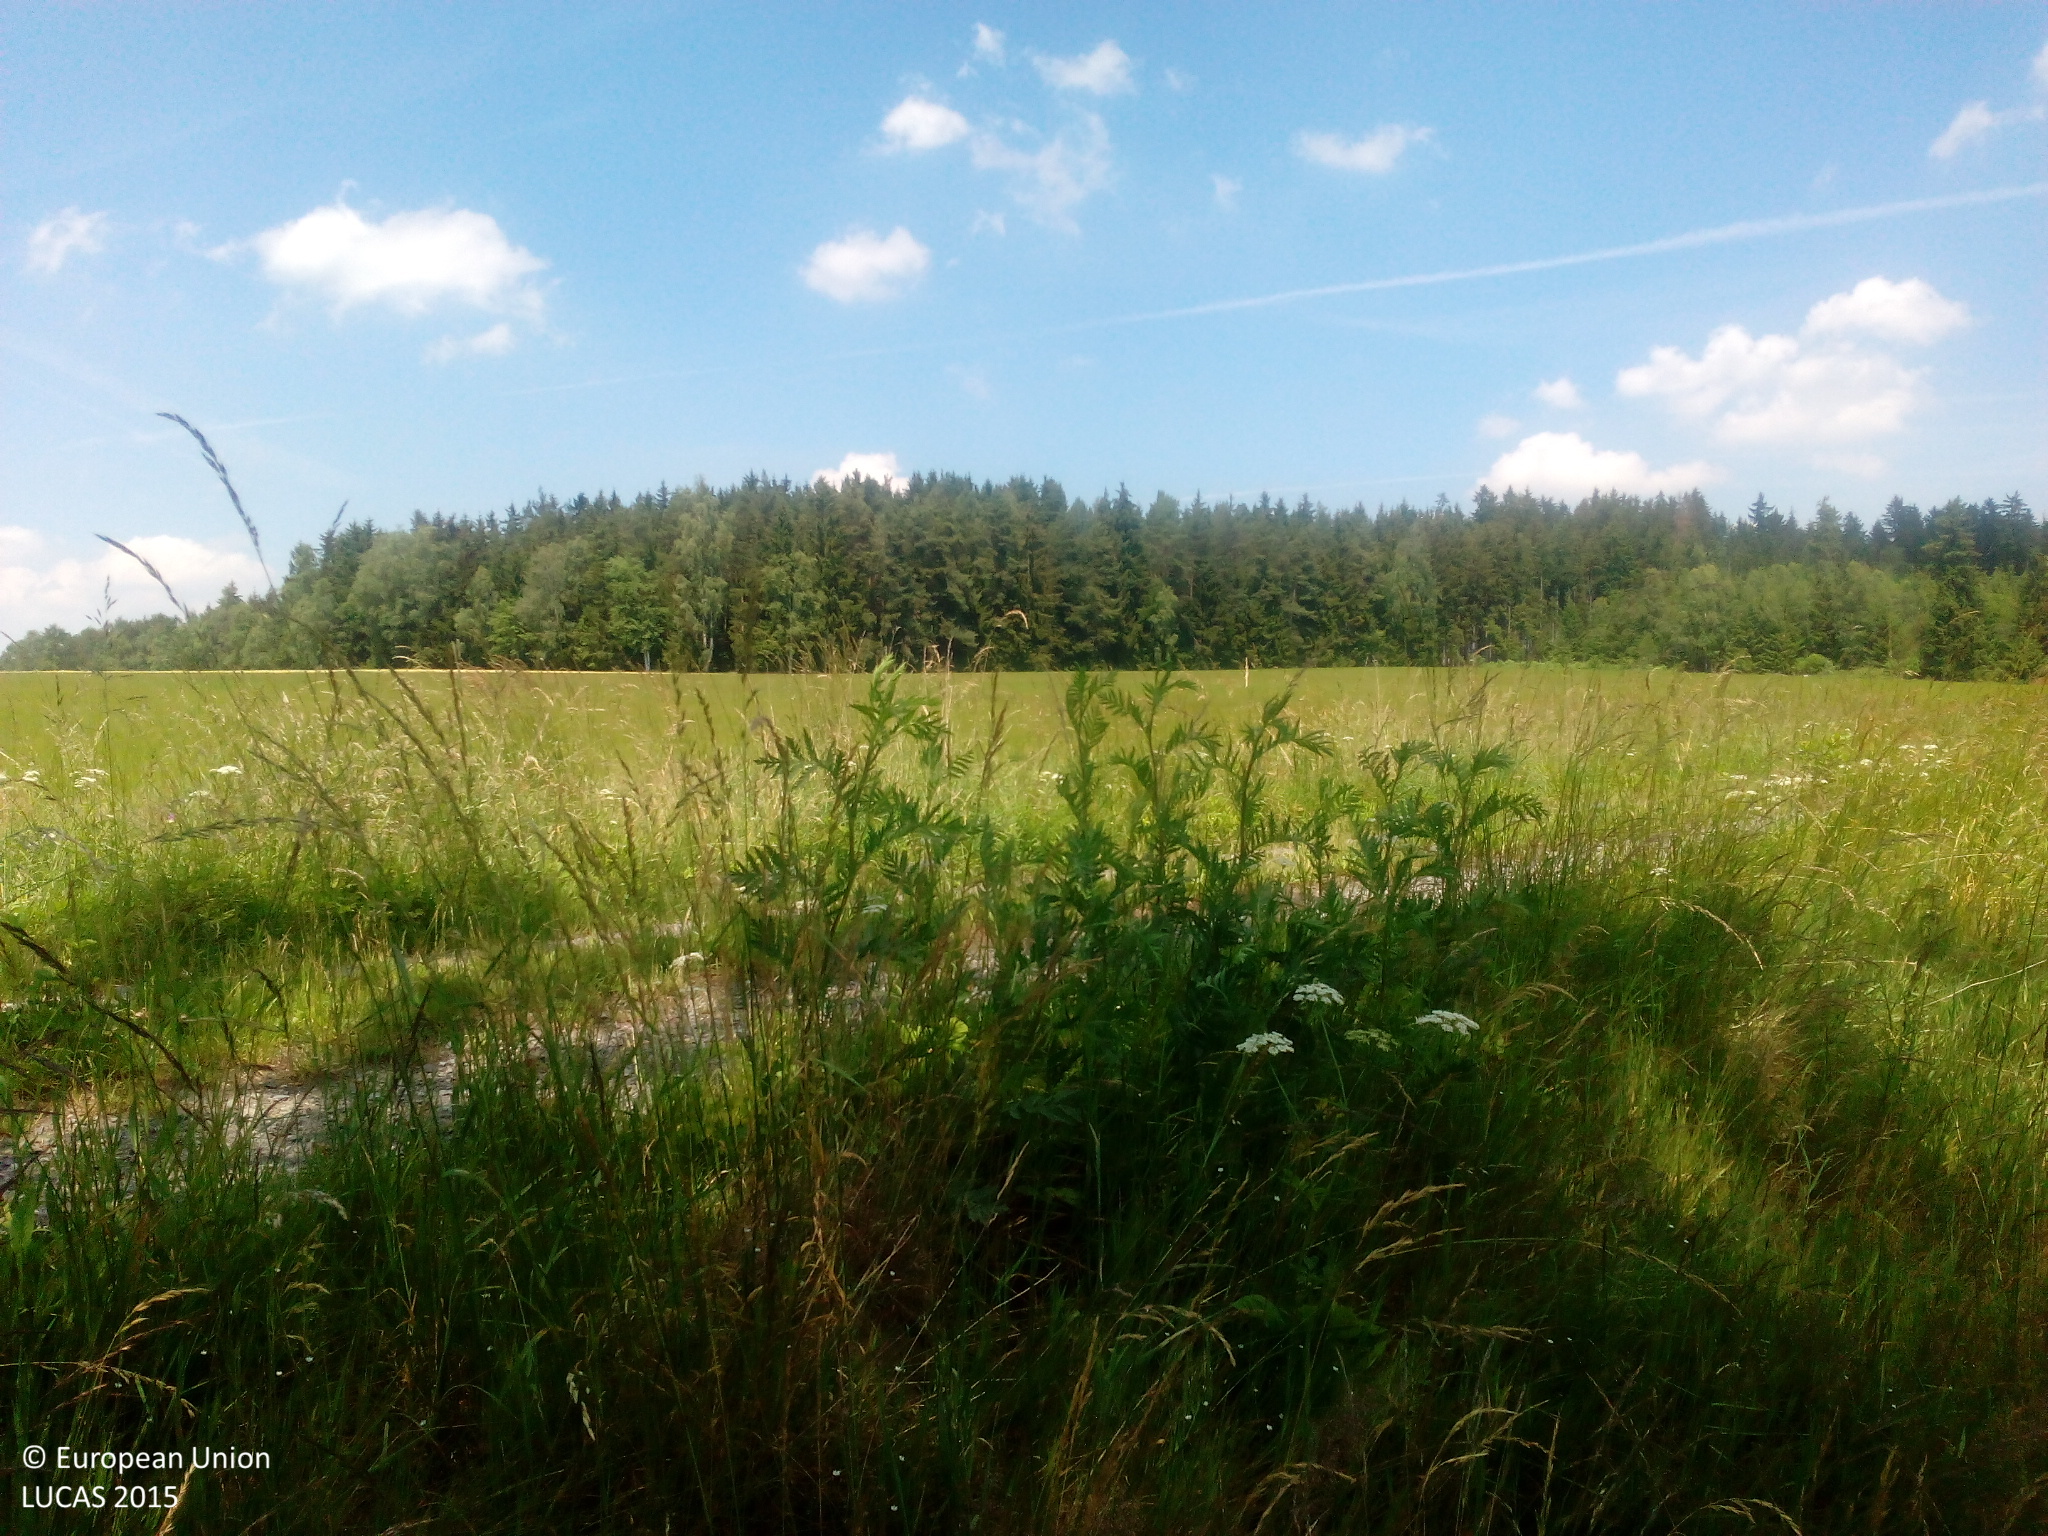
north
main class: Woodland
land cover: Broadleaved woodland
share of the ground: 25 - 50 %
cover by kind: herbaceous plants 75 %, broadleaved forest trees 25 %
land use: Road transport
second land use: Agriculture (excluding fallow land and kitchen gardens)
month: June
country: DE
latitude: 50.1482
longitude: 12.0288
